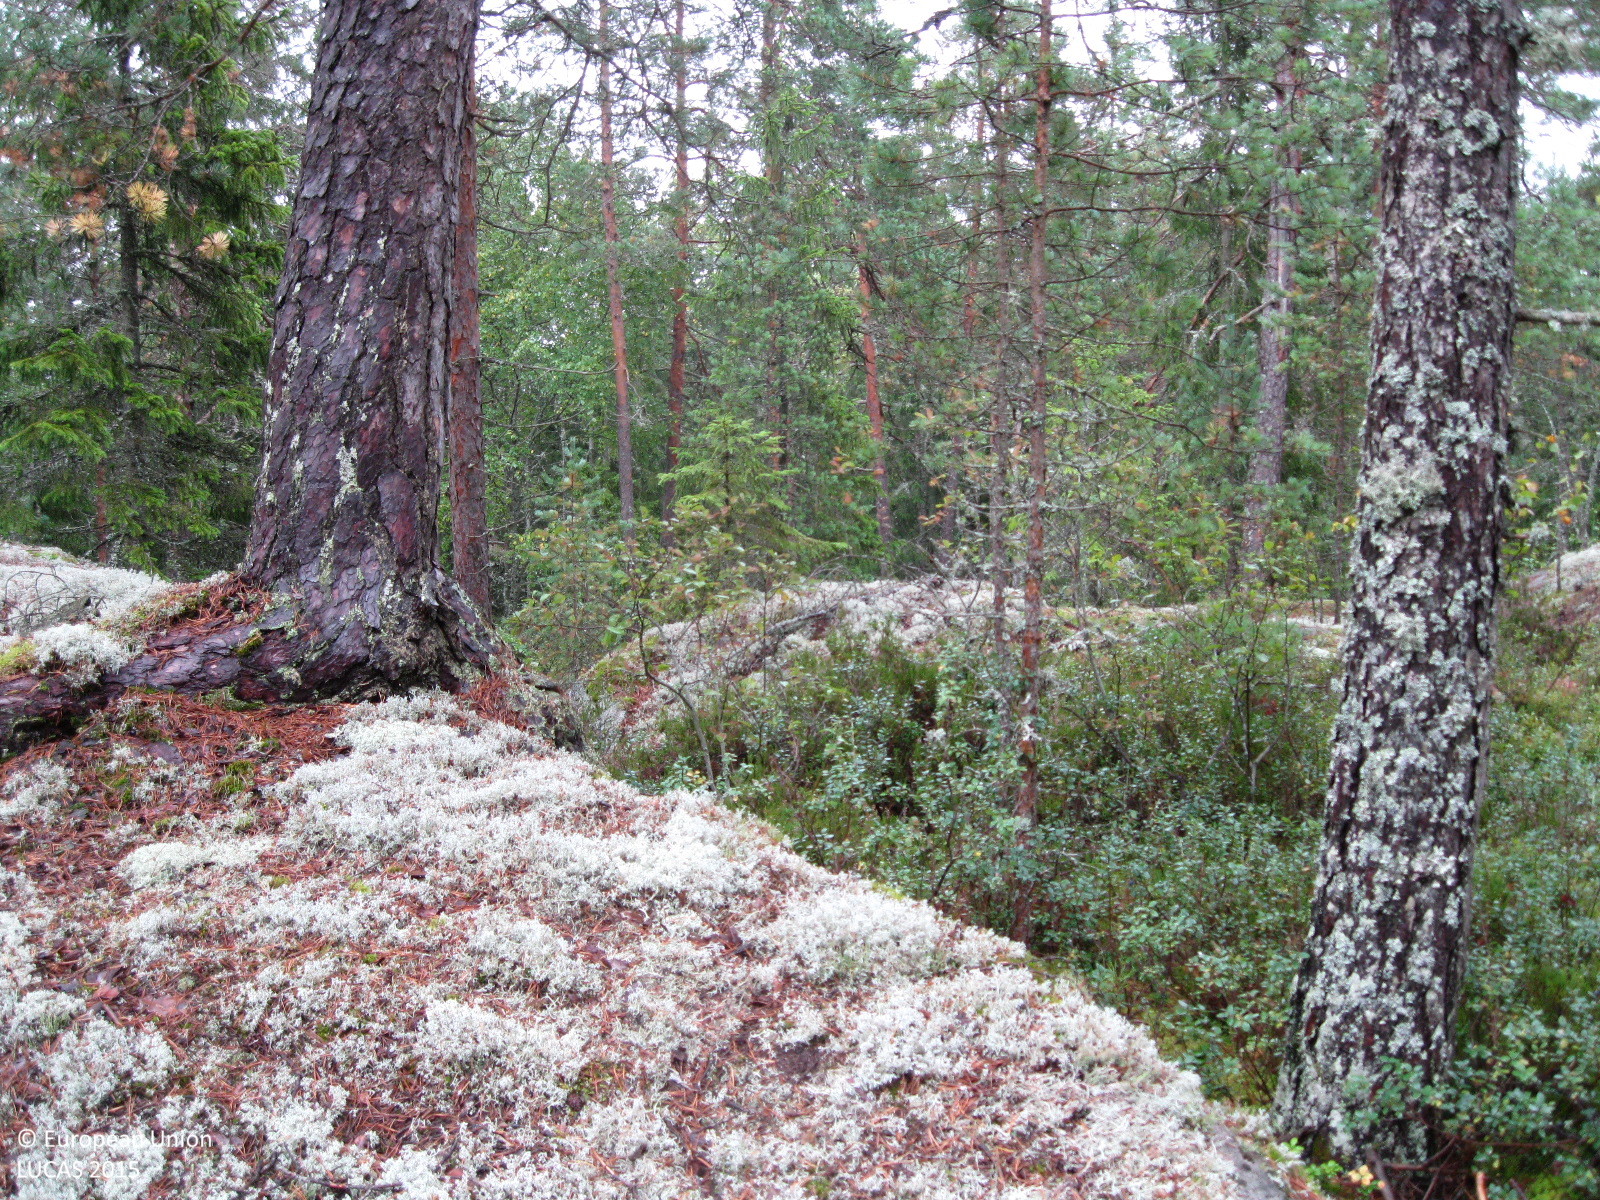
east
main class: Woodland
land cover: Pine dominated coniferous woodland
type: boreal forest
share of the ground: 25 - 50 %
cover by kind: shrubs 50 %, coniferous forest trees 25 %, herbaceous plants 20 %, lichens and mosses 5 %
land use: Forestry
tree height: > 5 m
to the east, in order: Pine dominated coniferous woodland; Spruce dominated coniferous woodland; Pine dominated coniferous woodland; Spruce dominated mixed woodland; Spruce dominated coniferous woodland; Ditches and canals; Spruce dominated coniferous woodland; Tracks; Ditches and canals; Broadleaved woodland
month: September
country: FI
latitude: 60.2748
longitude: 24.6292
